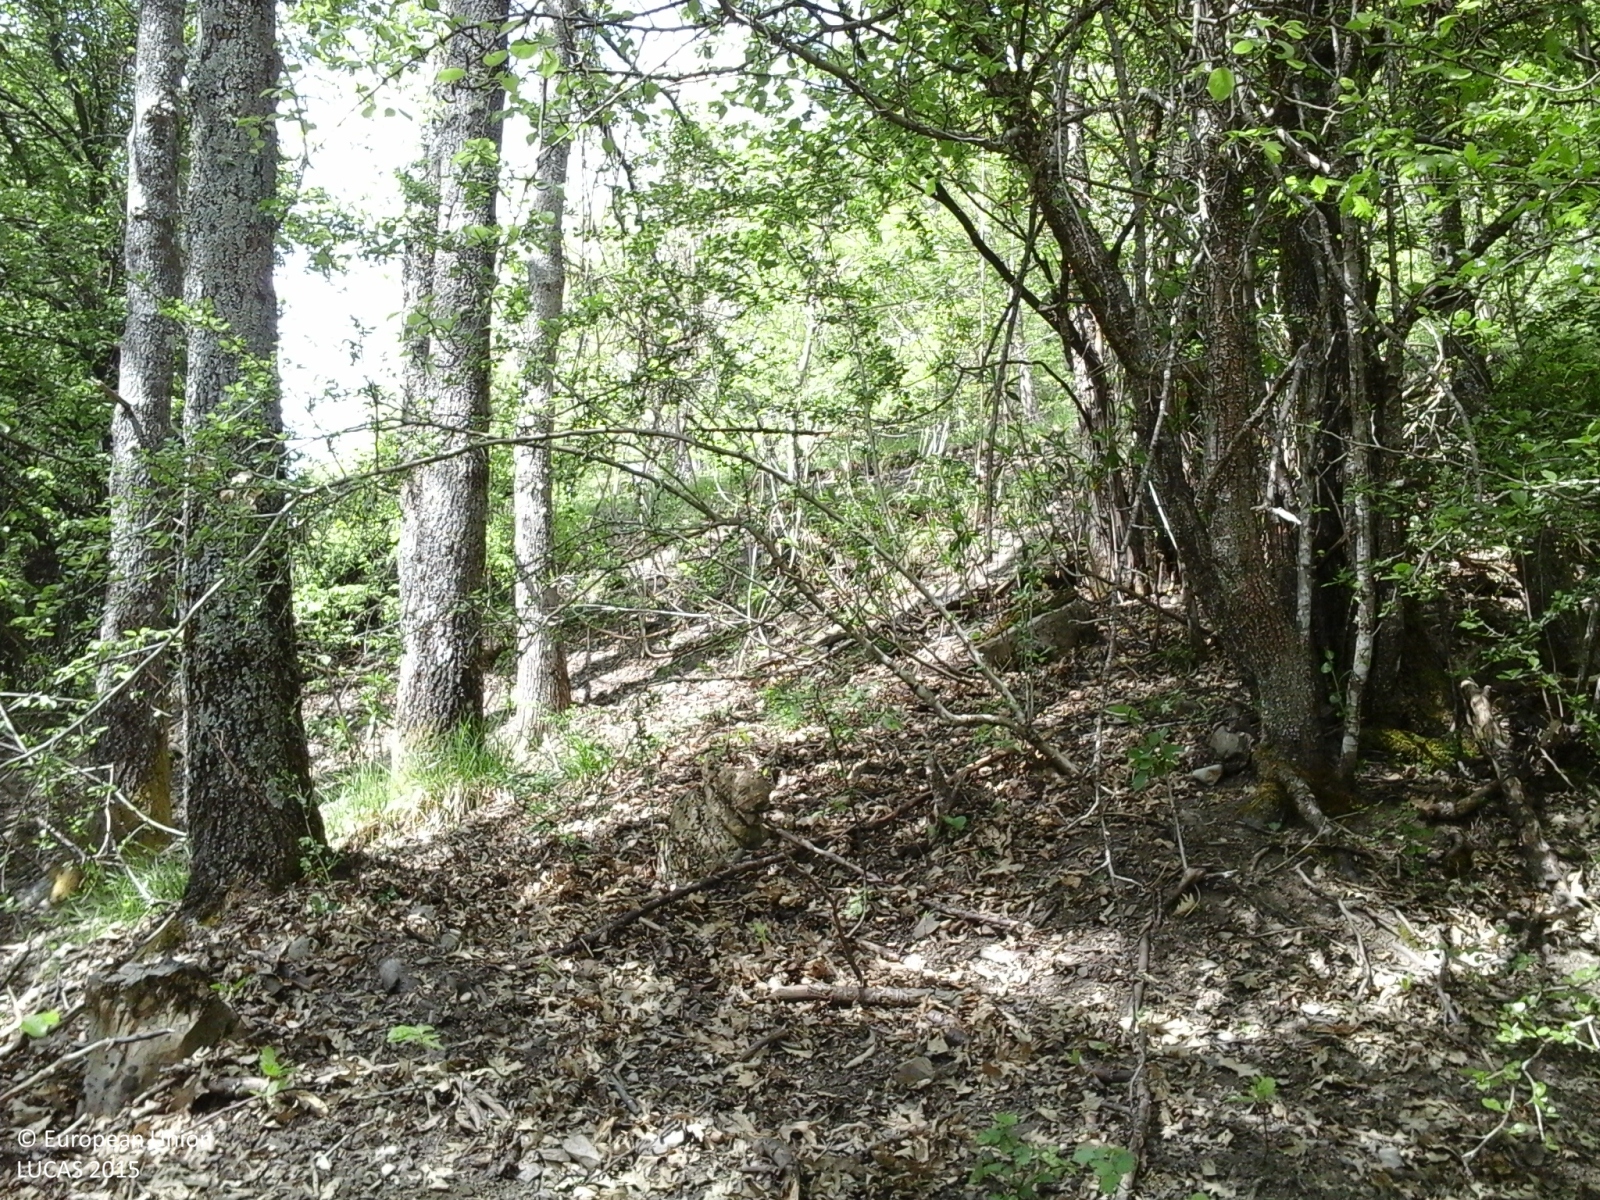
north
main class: Woodland
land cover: Other mixed woodland
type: thermophilous deciduous forest
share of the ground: > 75 %
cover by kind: broadleaved forest trees 50 %, coniferous forest trees 25 %, shrubs 25 %
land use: Forestry
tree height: > 5 m
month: May
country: IT
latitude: 44.6191
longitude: 9.3587
